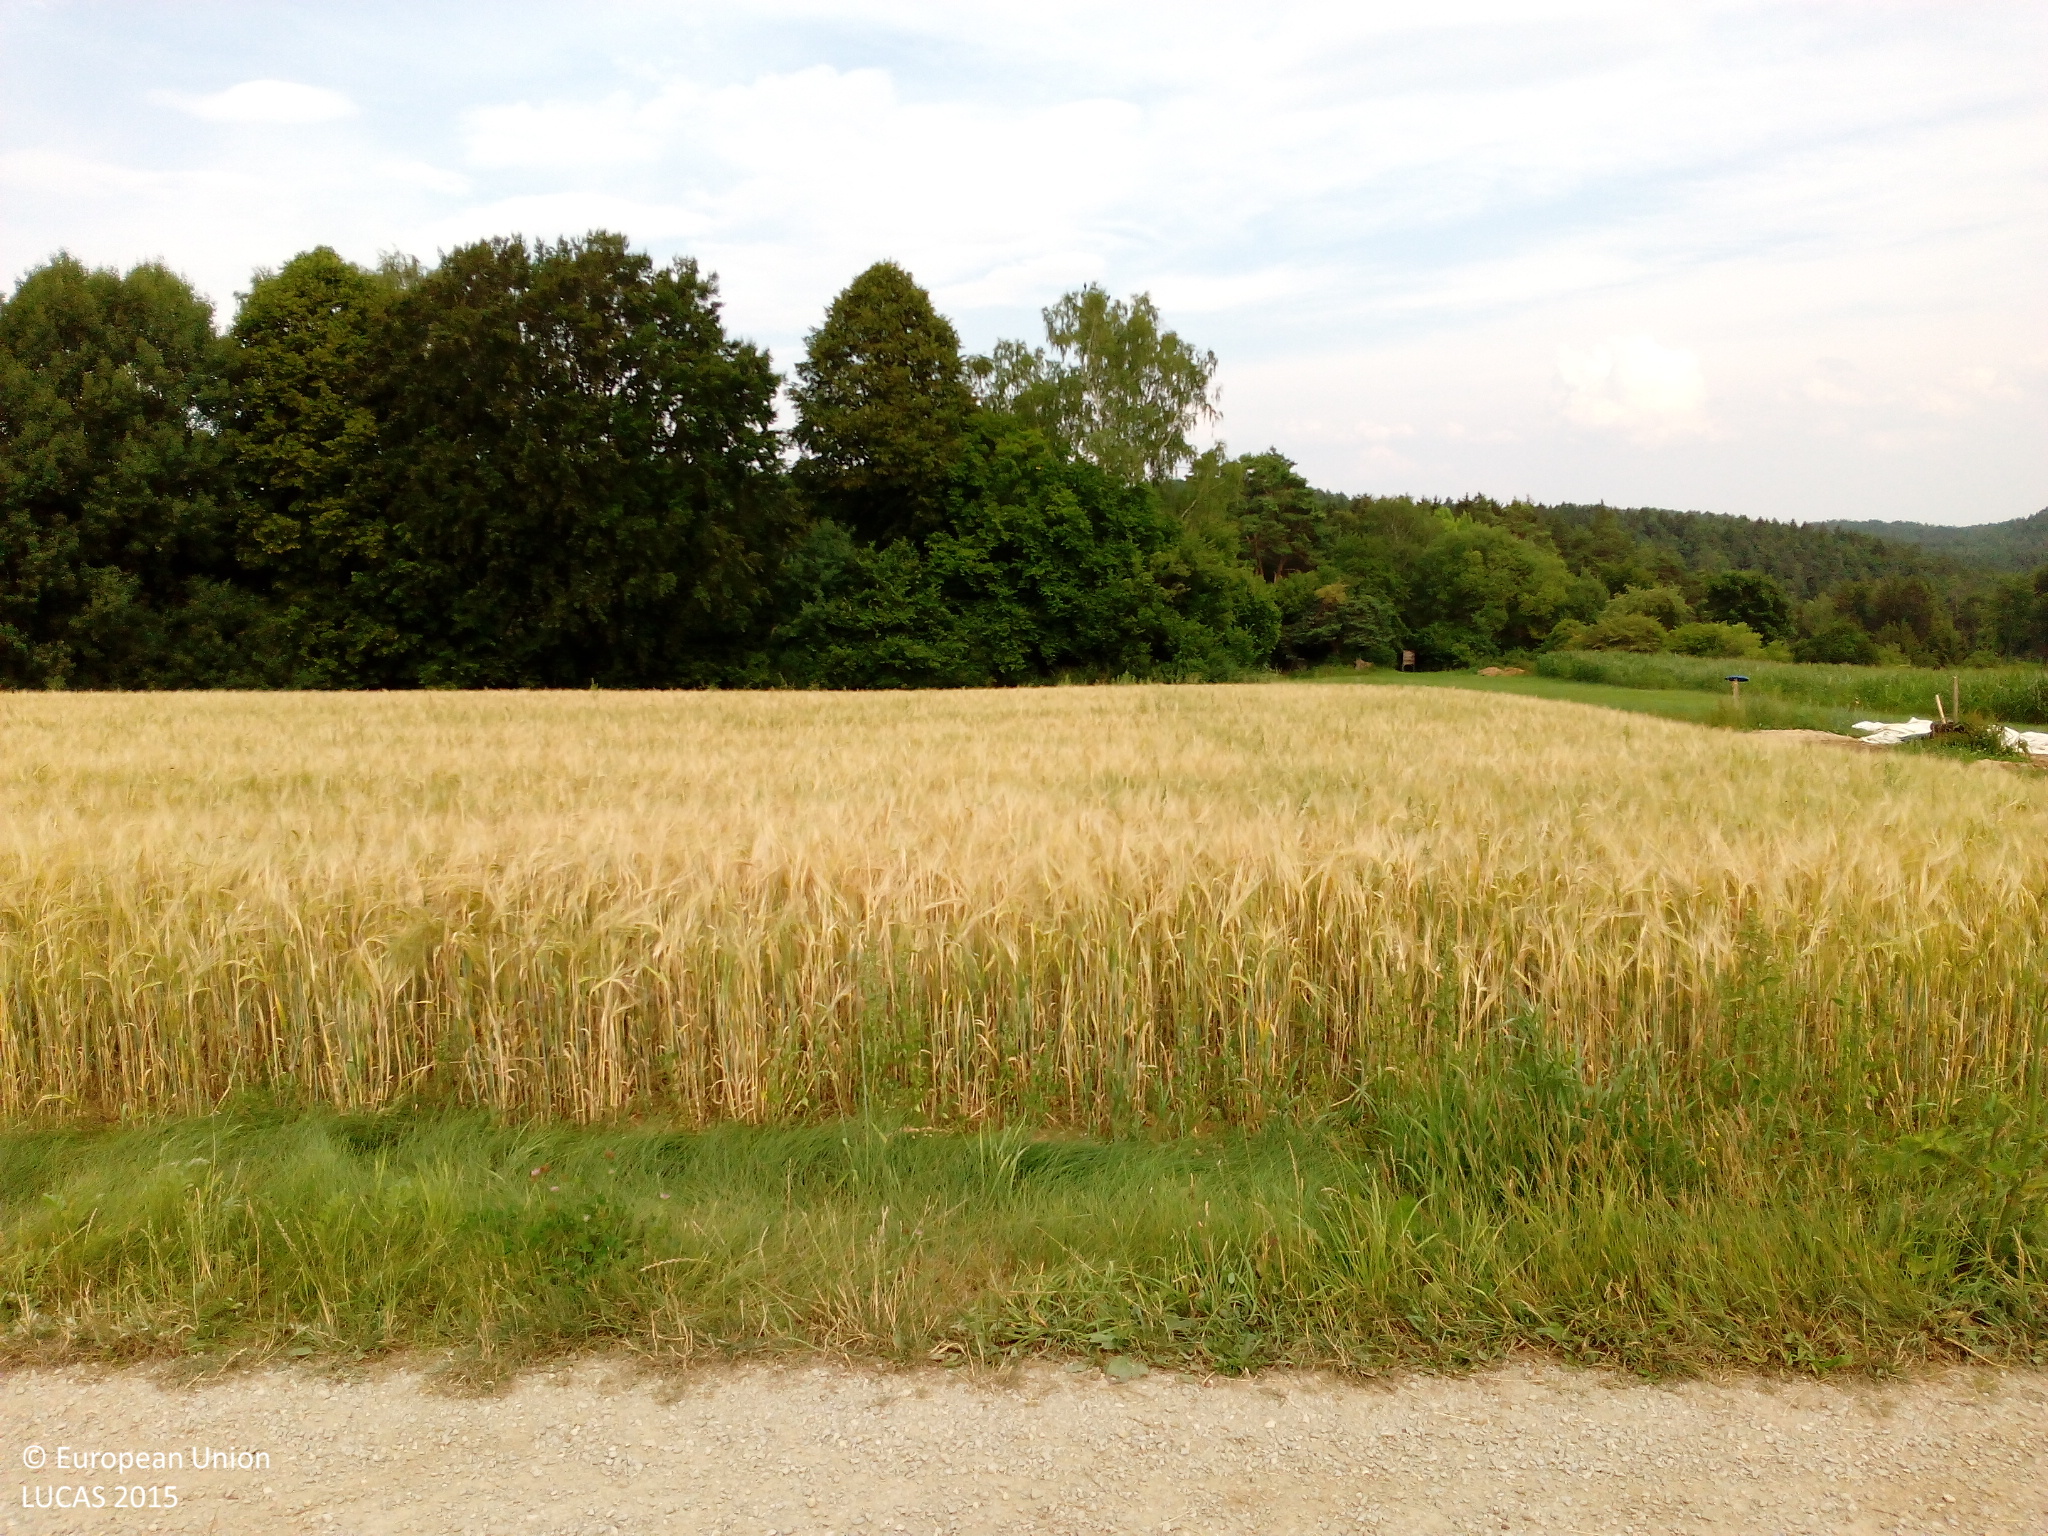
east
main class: Cropland
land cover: Barley
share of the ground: > 75 %
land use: Agriculture (excluding fallow land and kitchen gardens)
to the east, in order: Barley; Grass margins; Tracks; Grass margins; Barley; Grassland without tree/shrub cover; Broadleaved woodland; Pine dominated mixed woodland; Tracks; Fences; Pine dominated coniferous woodland; Fences; Pine dominated mixed woodland
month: July
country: DE
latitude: 49.6350
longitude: 11.4811
